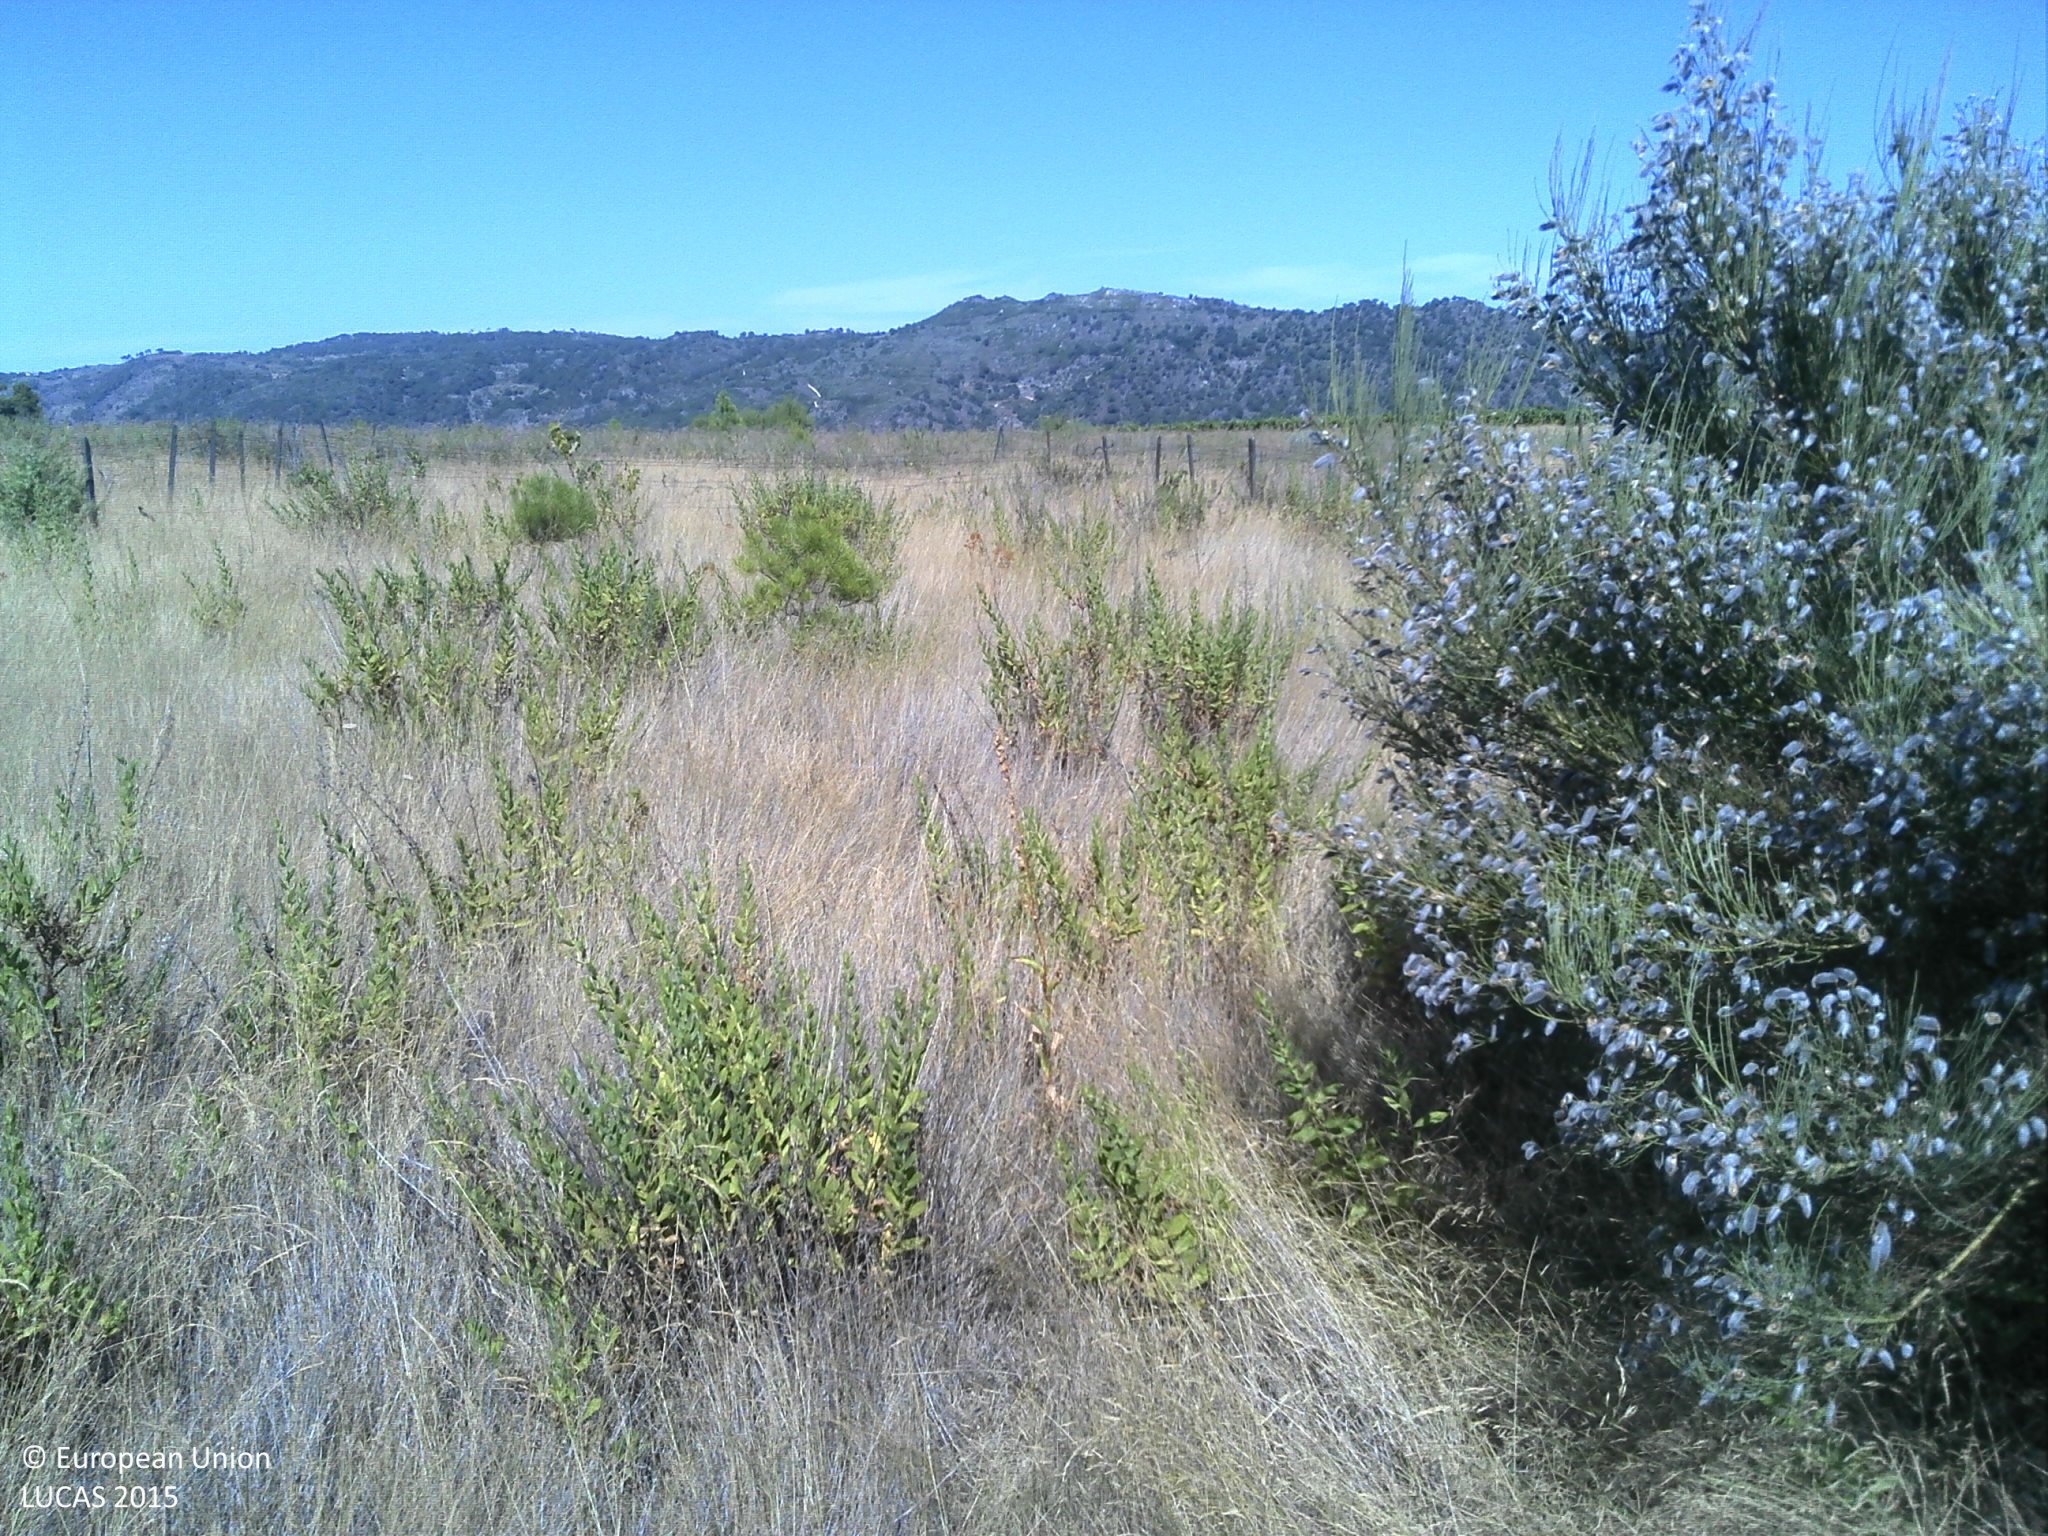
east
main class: Grassland
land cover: Grassland with sparse tree/shrub cover
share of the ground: > 75 %
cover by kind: herbaceous plants 85 %, coniferous forest trees 5 %, shrubs 5 %, unconsolidated bare surface 5 %
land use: Agriculture (excluding fallow land and kitchen gardens)
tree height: < 5 m
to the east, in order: Grassland with sparse tree/shrub cover; Fences; Vineyards; Shrubland without tree cover; Tracks; Grassland without tree/shrub cover; Tracks; Vineyards; Ditches and canals; Tracks; Grassland without tree/shrub cover
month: July
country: PT
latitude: 41.1758
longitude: -7.2694
